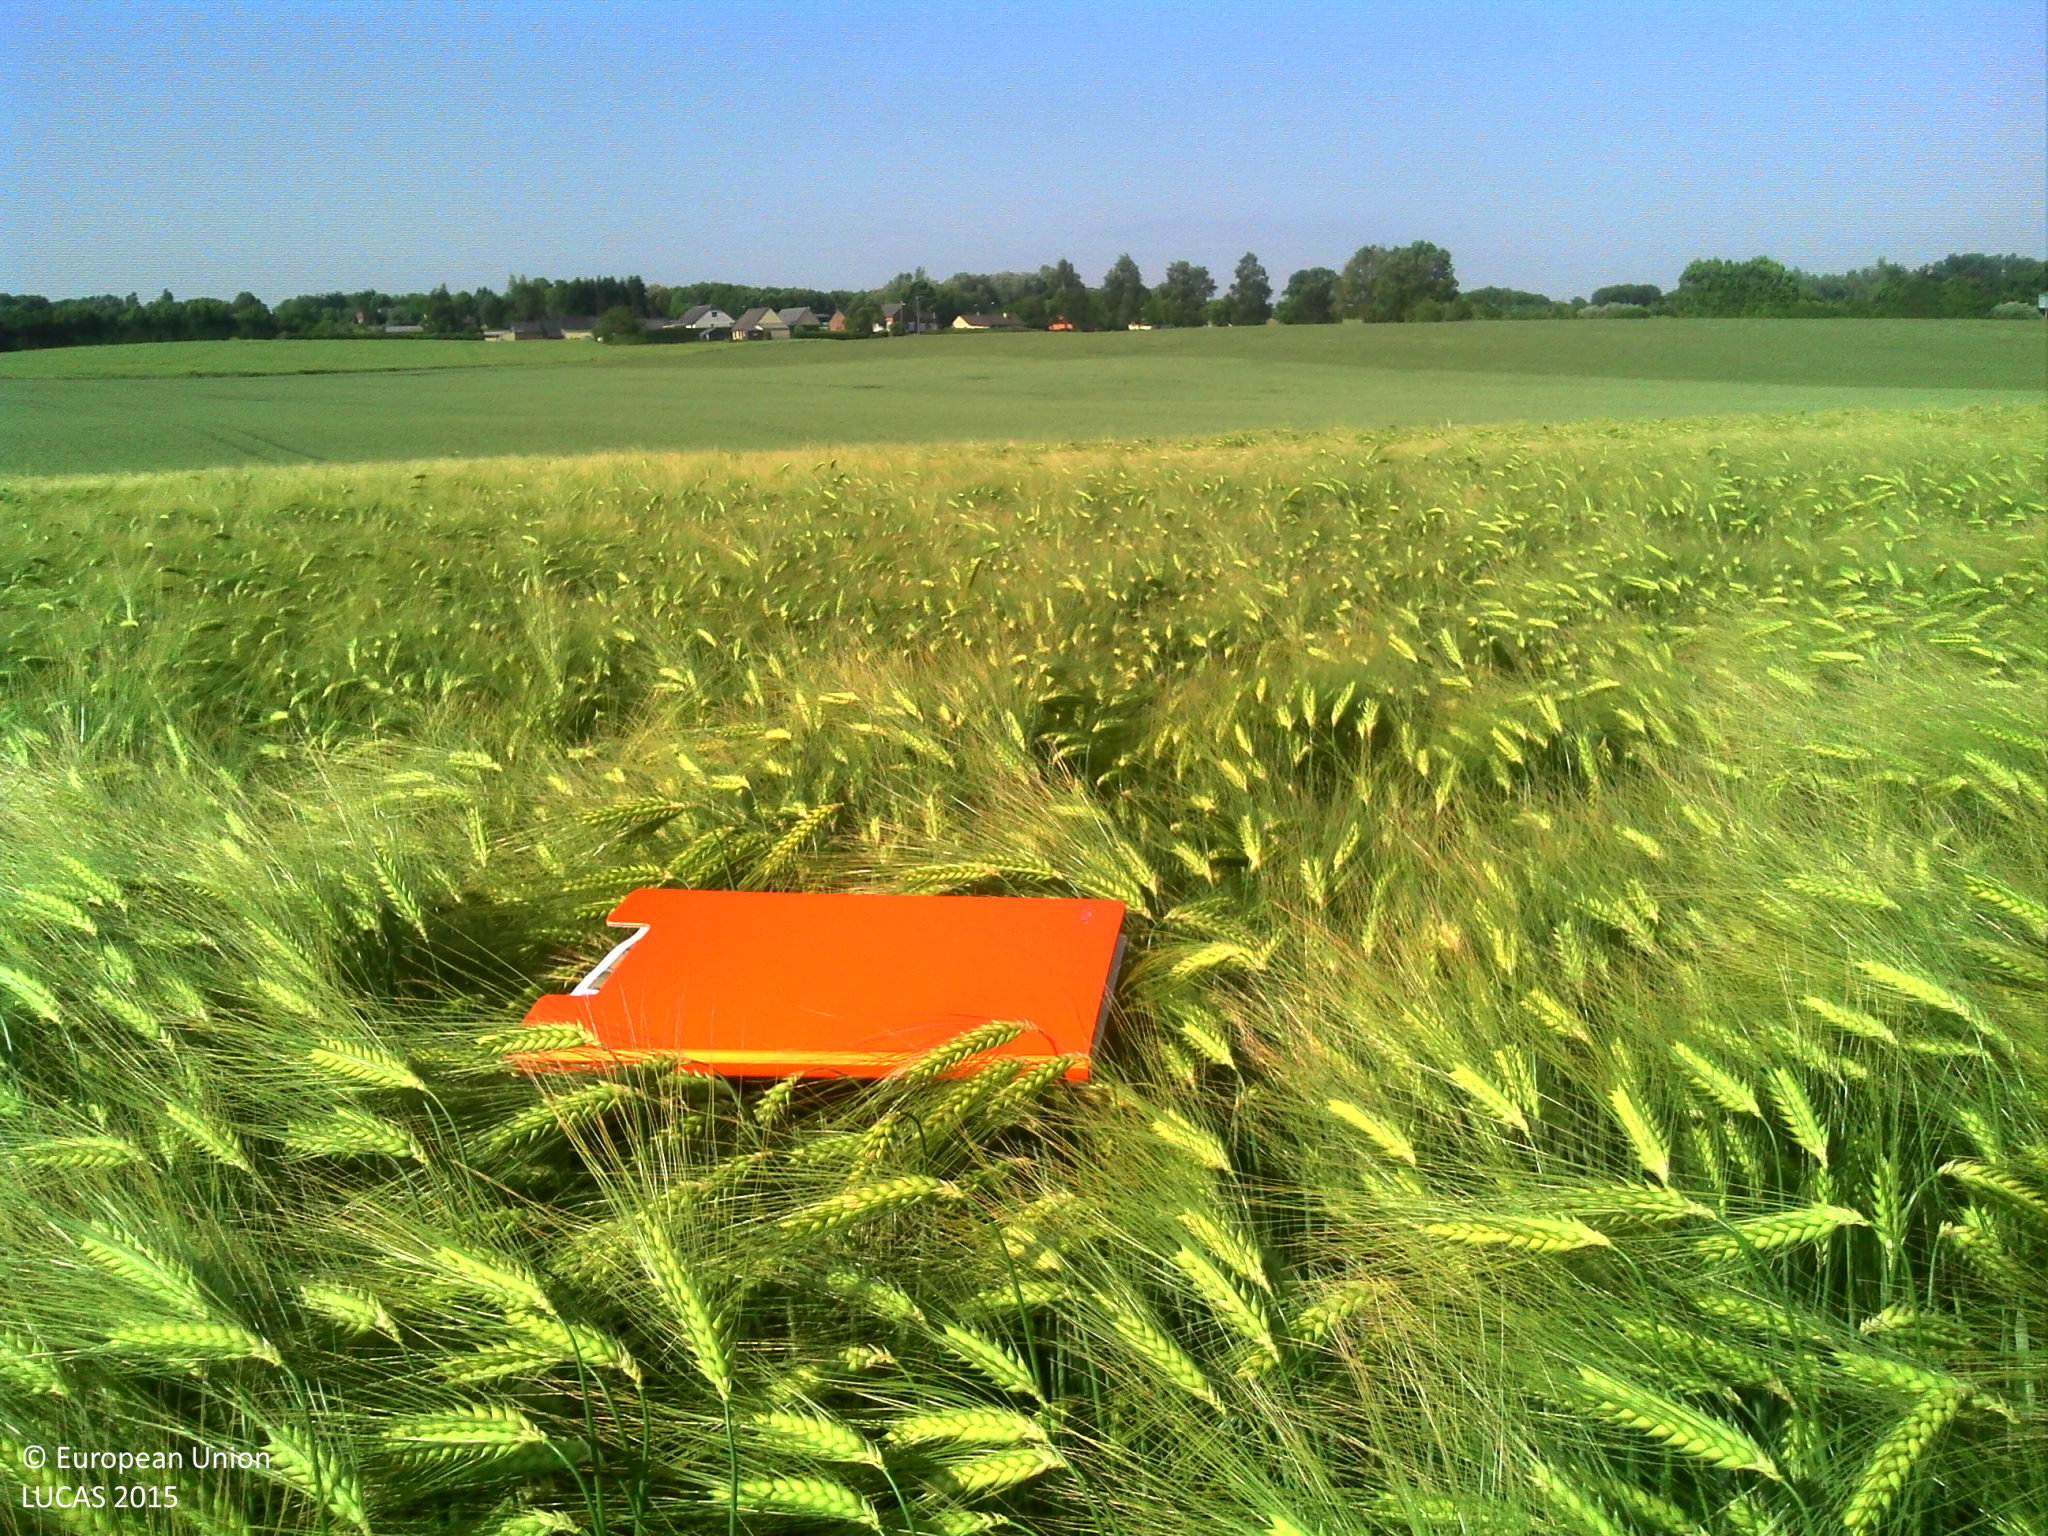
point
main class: Cropland
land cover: Barley
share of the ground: > 75 %
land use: Agriculture (excluding fallow land and kitchen gardens)
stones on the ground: < 10 %
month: June
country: FR
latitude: 49.8833
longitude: 4.0240
